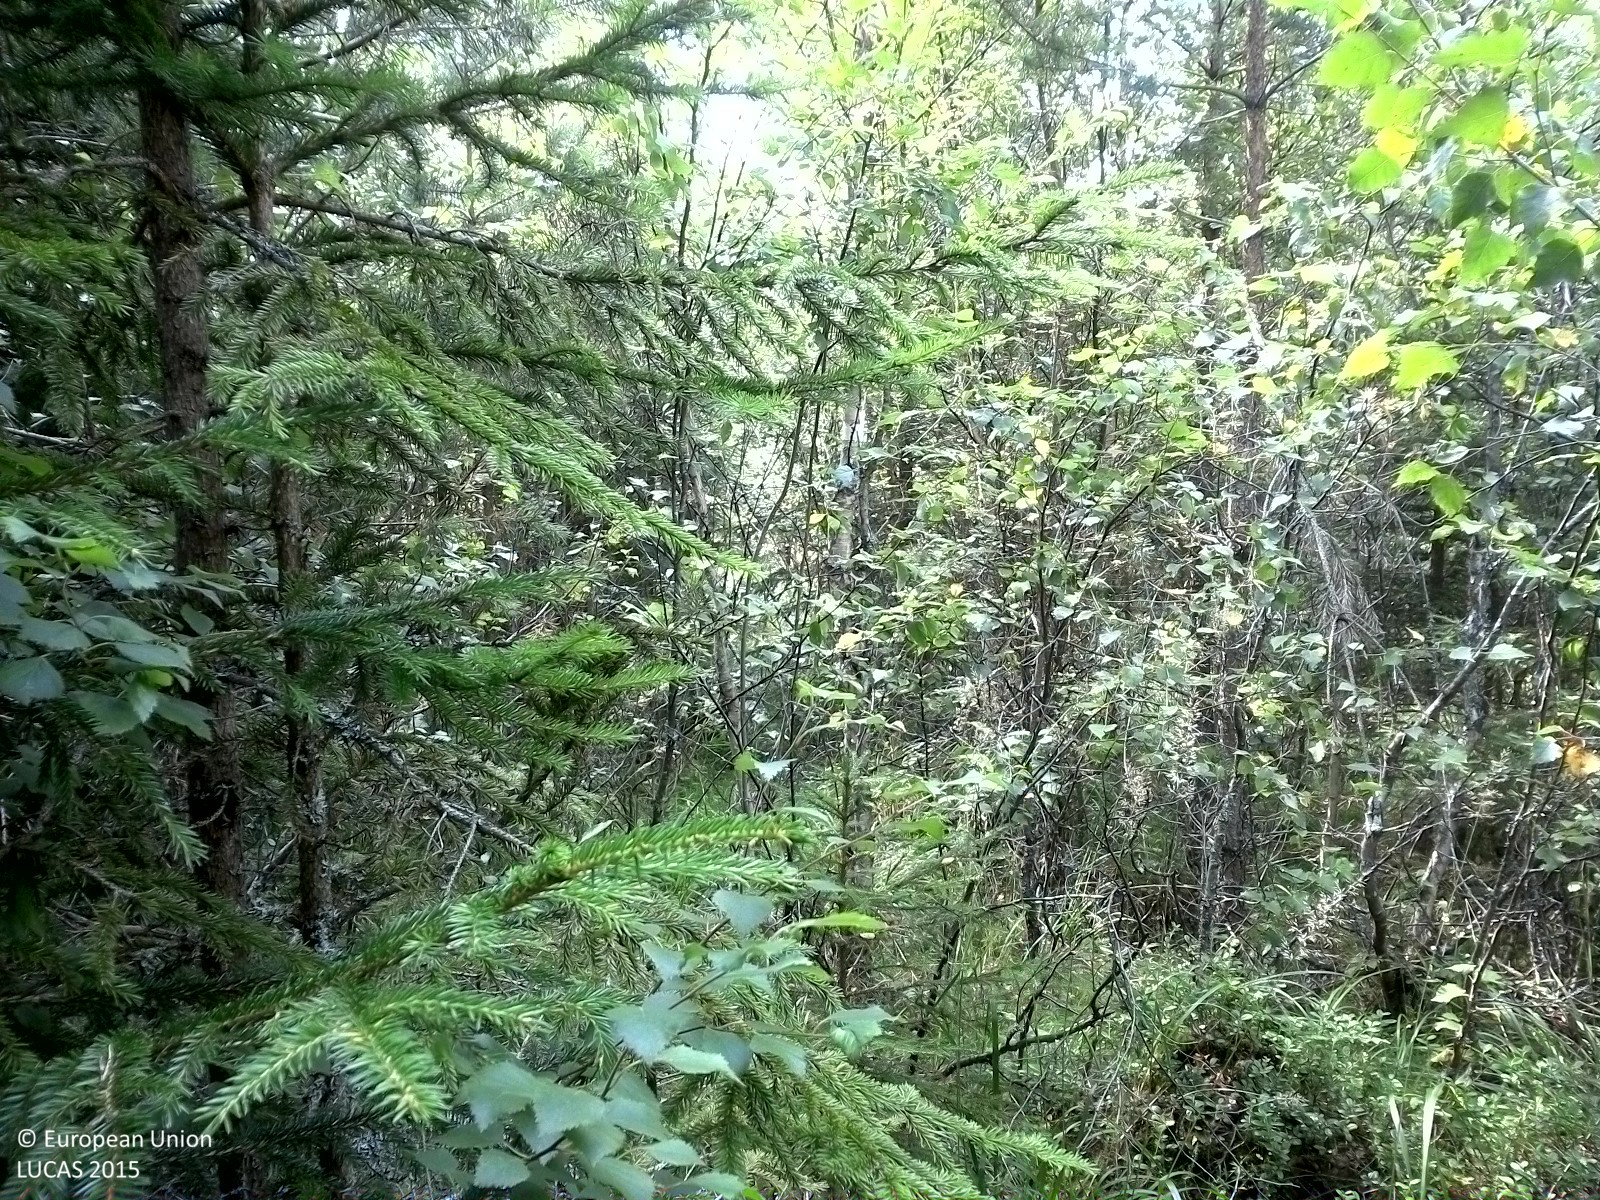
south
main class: Woodland
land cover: Other mixed woodland
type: boreal forest
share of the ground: > 75 %
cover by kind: coniferous forest trees 45 %, broadleaved forest trees 35 %, herbaceous plants 20 %
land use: Forestry
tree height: < 5 m
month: August
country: SE
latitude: 58.8691
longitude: 15.3862
